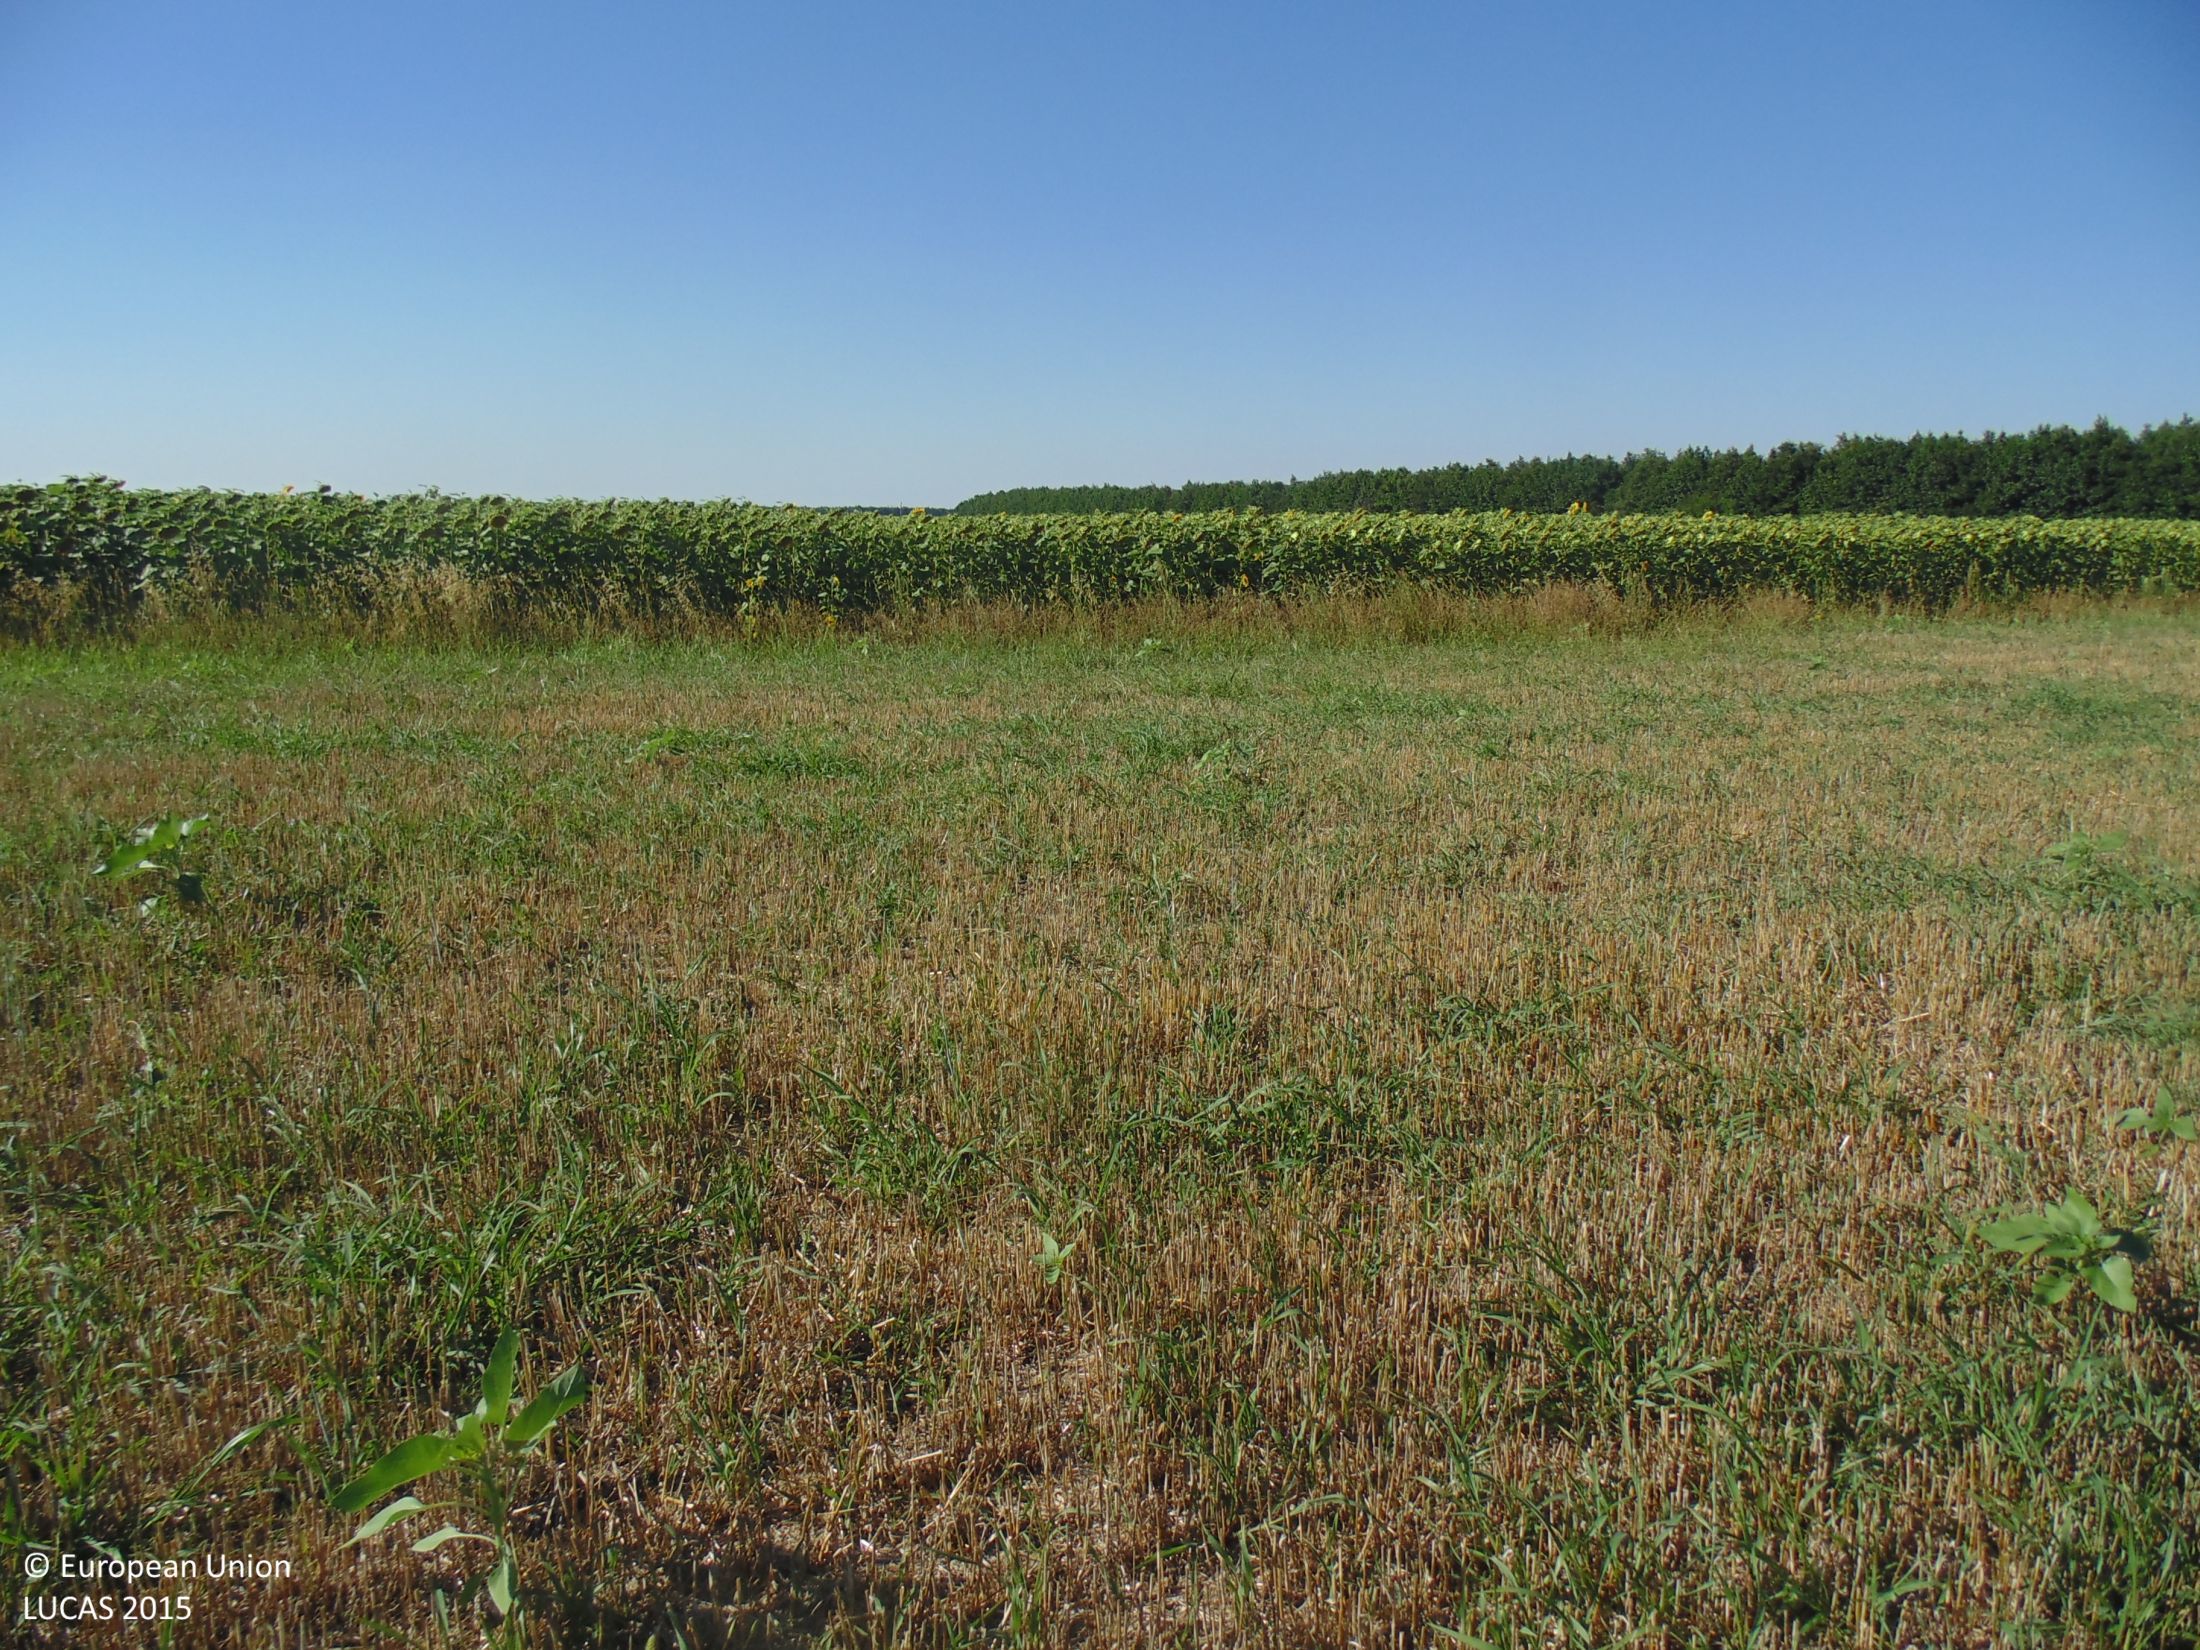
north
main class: Cropland
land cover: Barley
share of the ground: 10 - 25 %
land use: Agriculture (excluding fallow land and kitchen gardens)
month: July
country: BG
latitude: 43.4303
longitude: 28.0714
